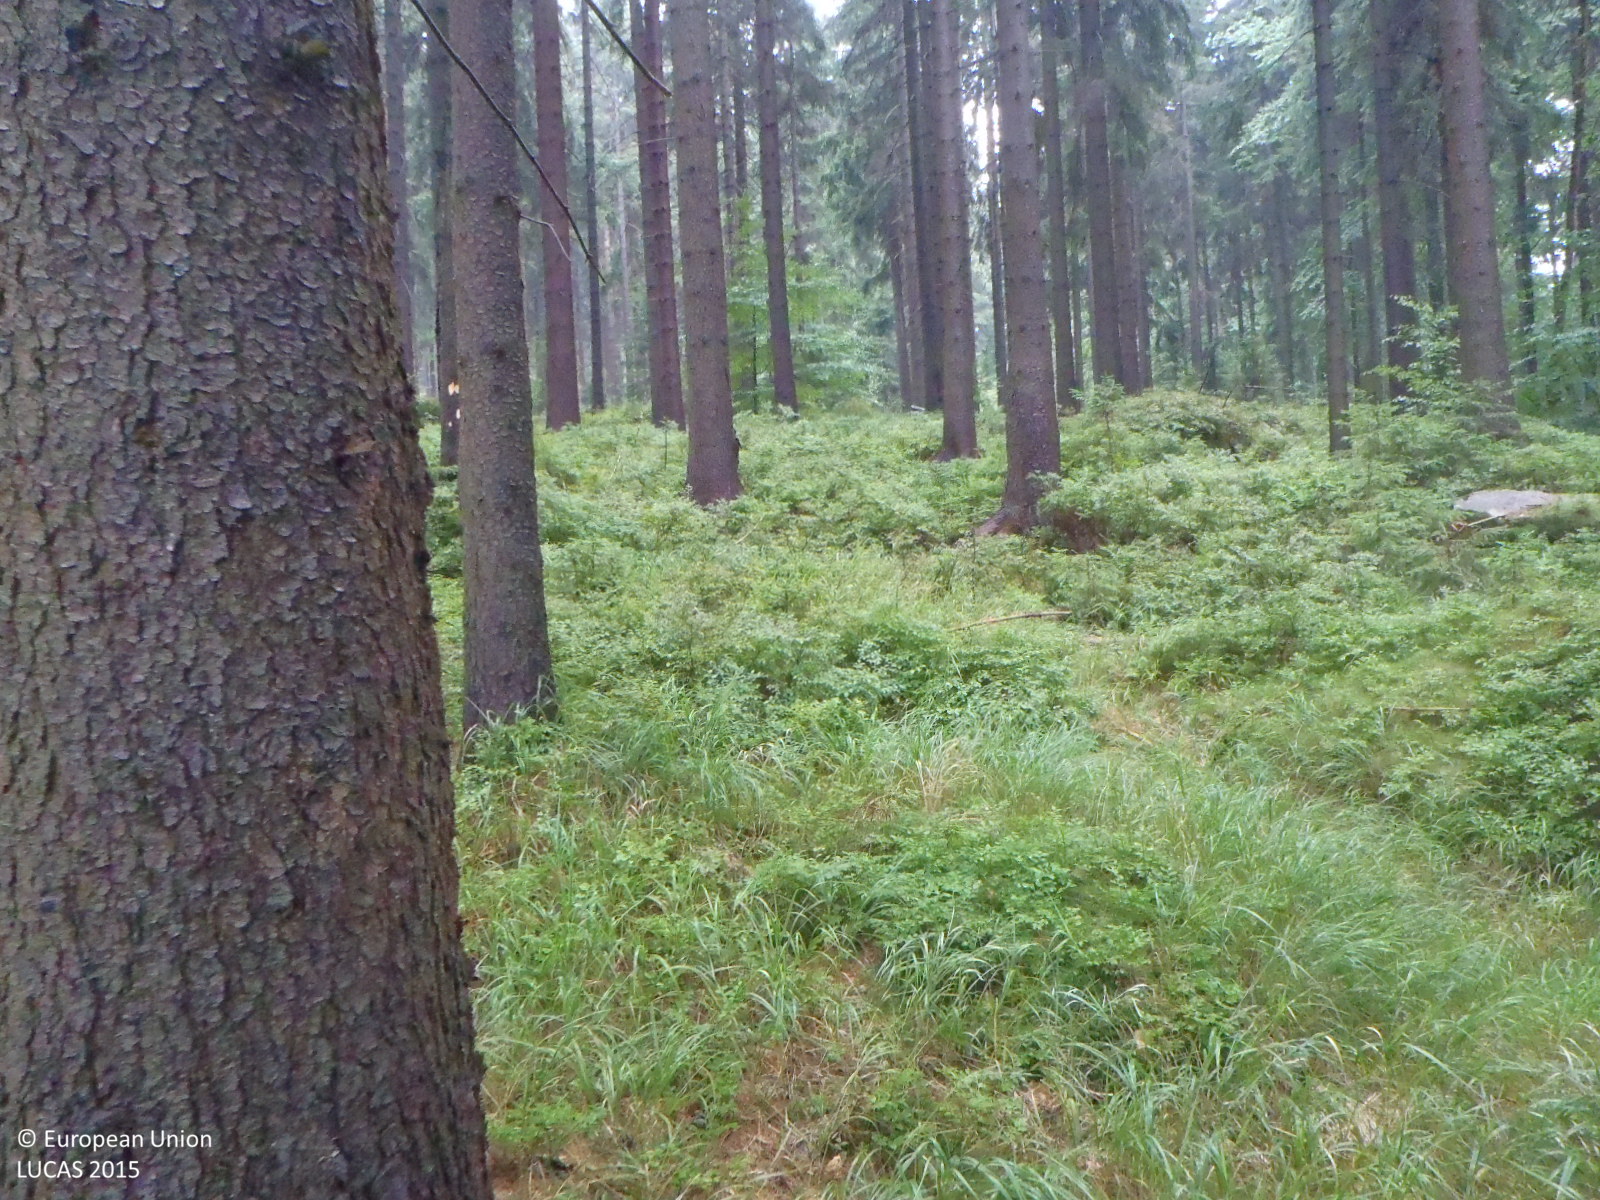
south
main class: Woodland
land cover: Spruce dominated coniferous woodland
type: hemiboreal forest and nemoral coniferous forest and mixed broadleaved-coniferous forest
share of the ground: > 75 %
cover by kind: coniferous forest trees 90 %, broadleaved forest trees 5 %, shrubs 5 %
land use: Forestry
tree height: > 5 m
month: August
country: CZ
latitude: 50.7834
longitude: 15.2657
